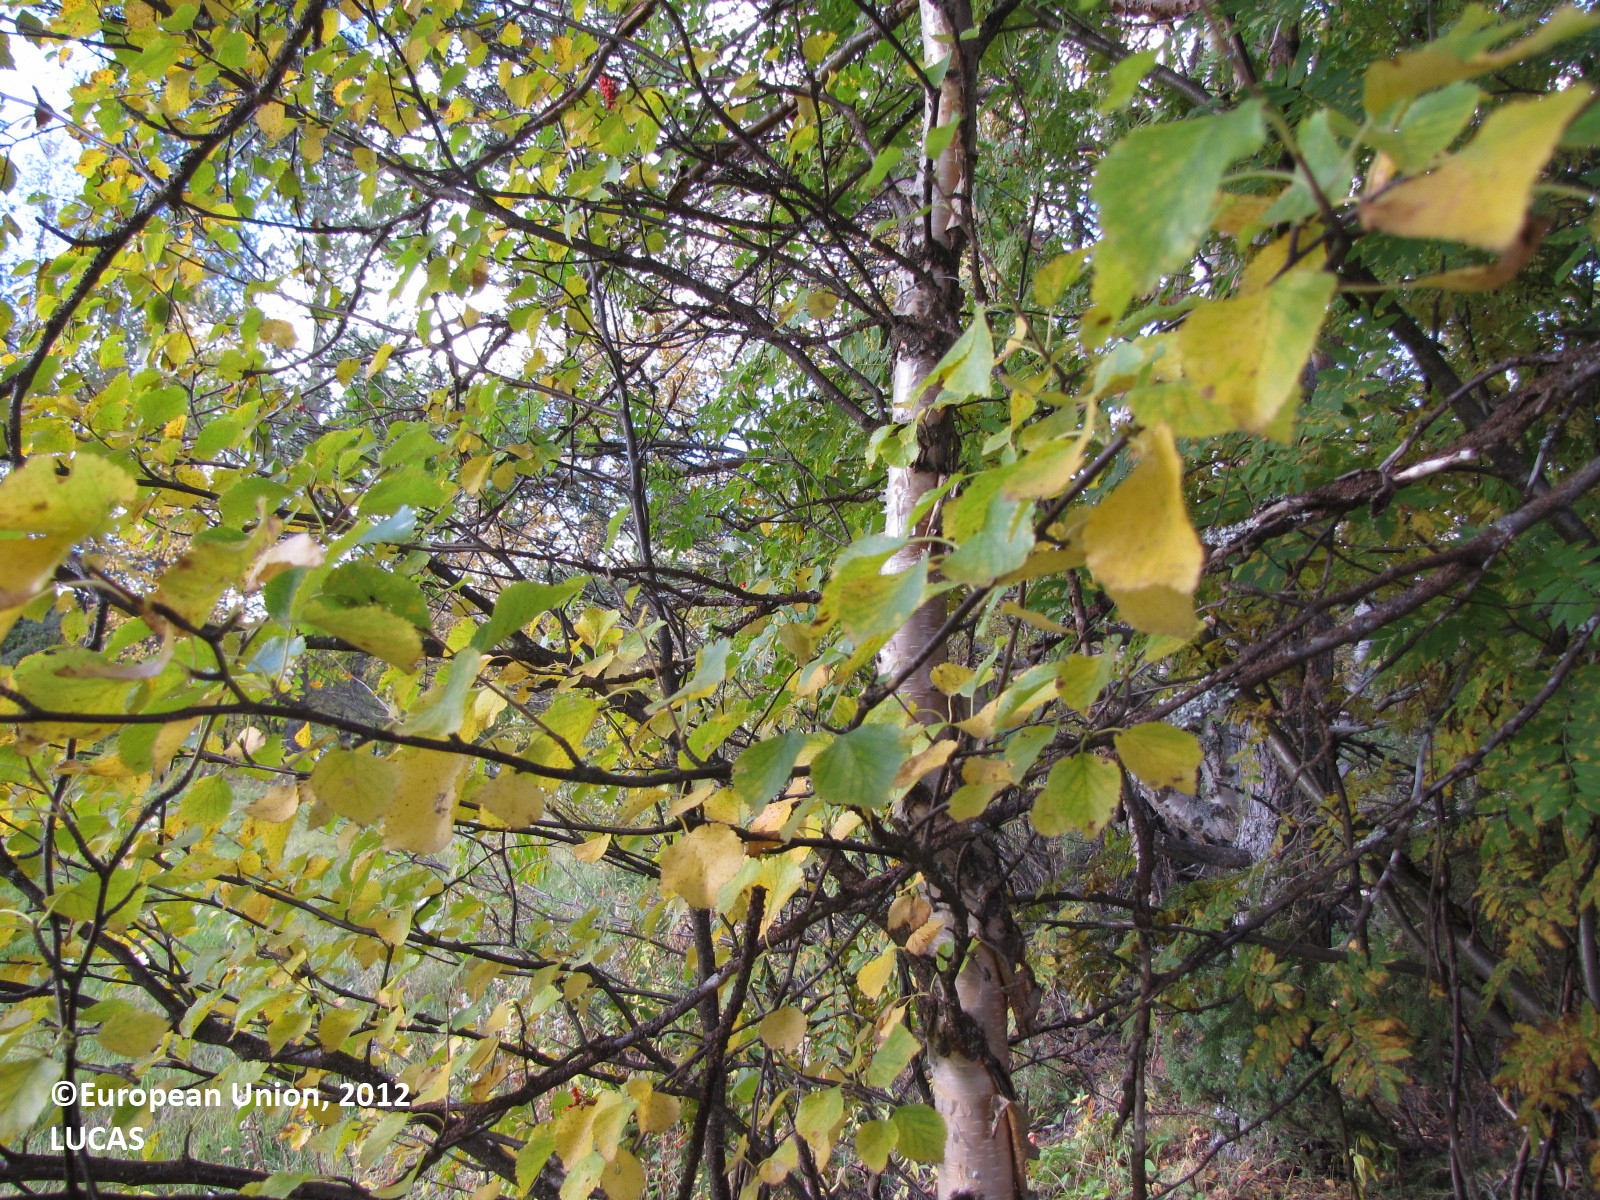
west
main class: Woodland
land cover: Pine dominated mixed woodland
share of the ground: 10 - 25 %
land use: Forestry
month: September
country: FI
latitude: 67.3706
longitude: 24.8745
